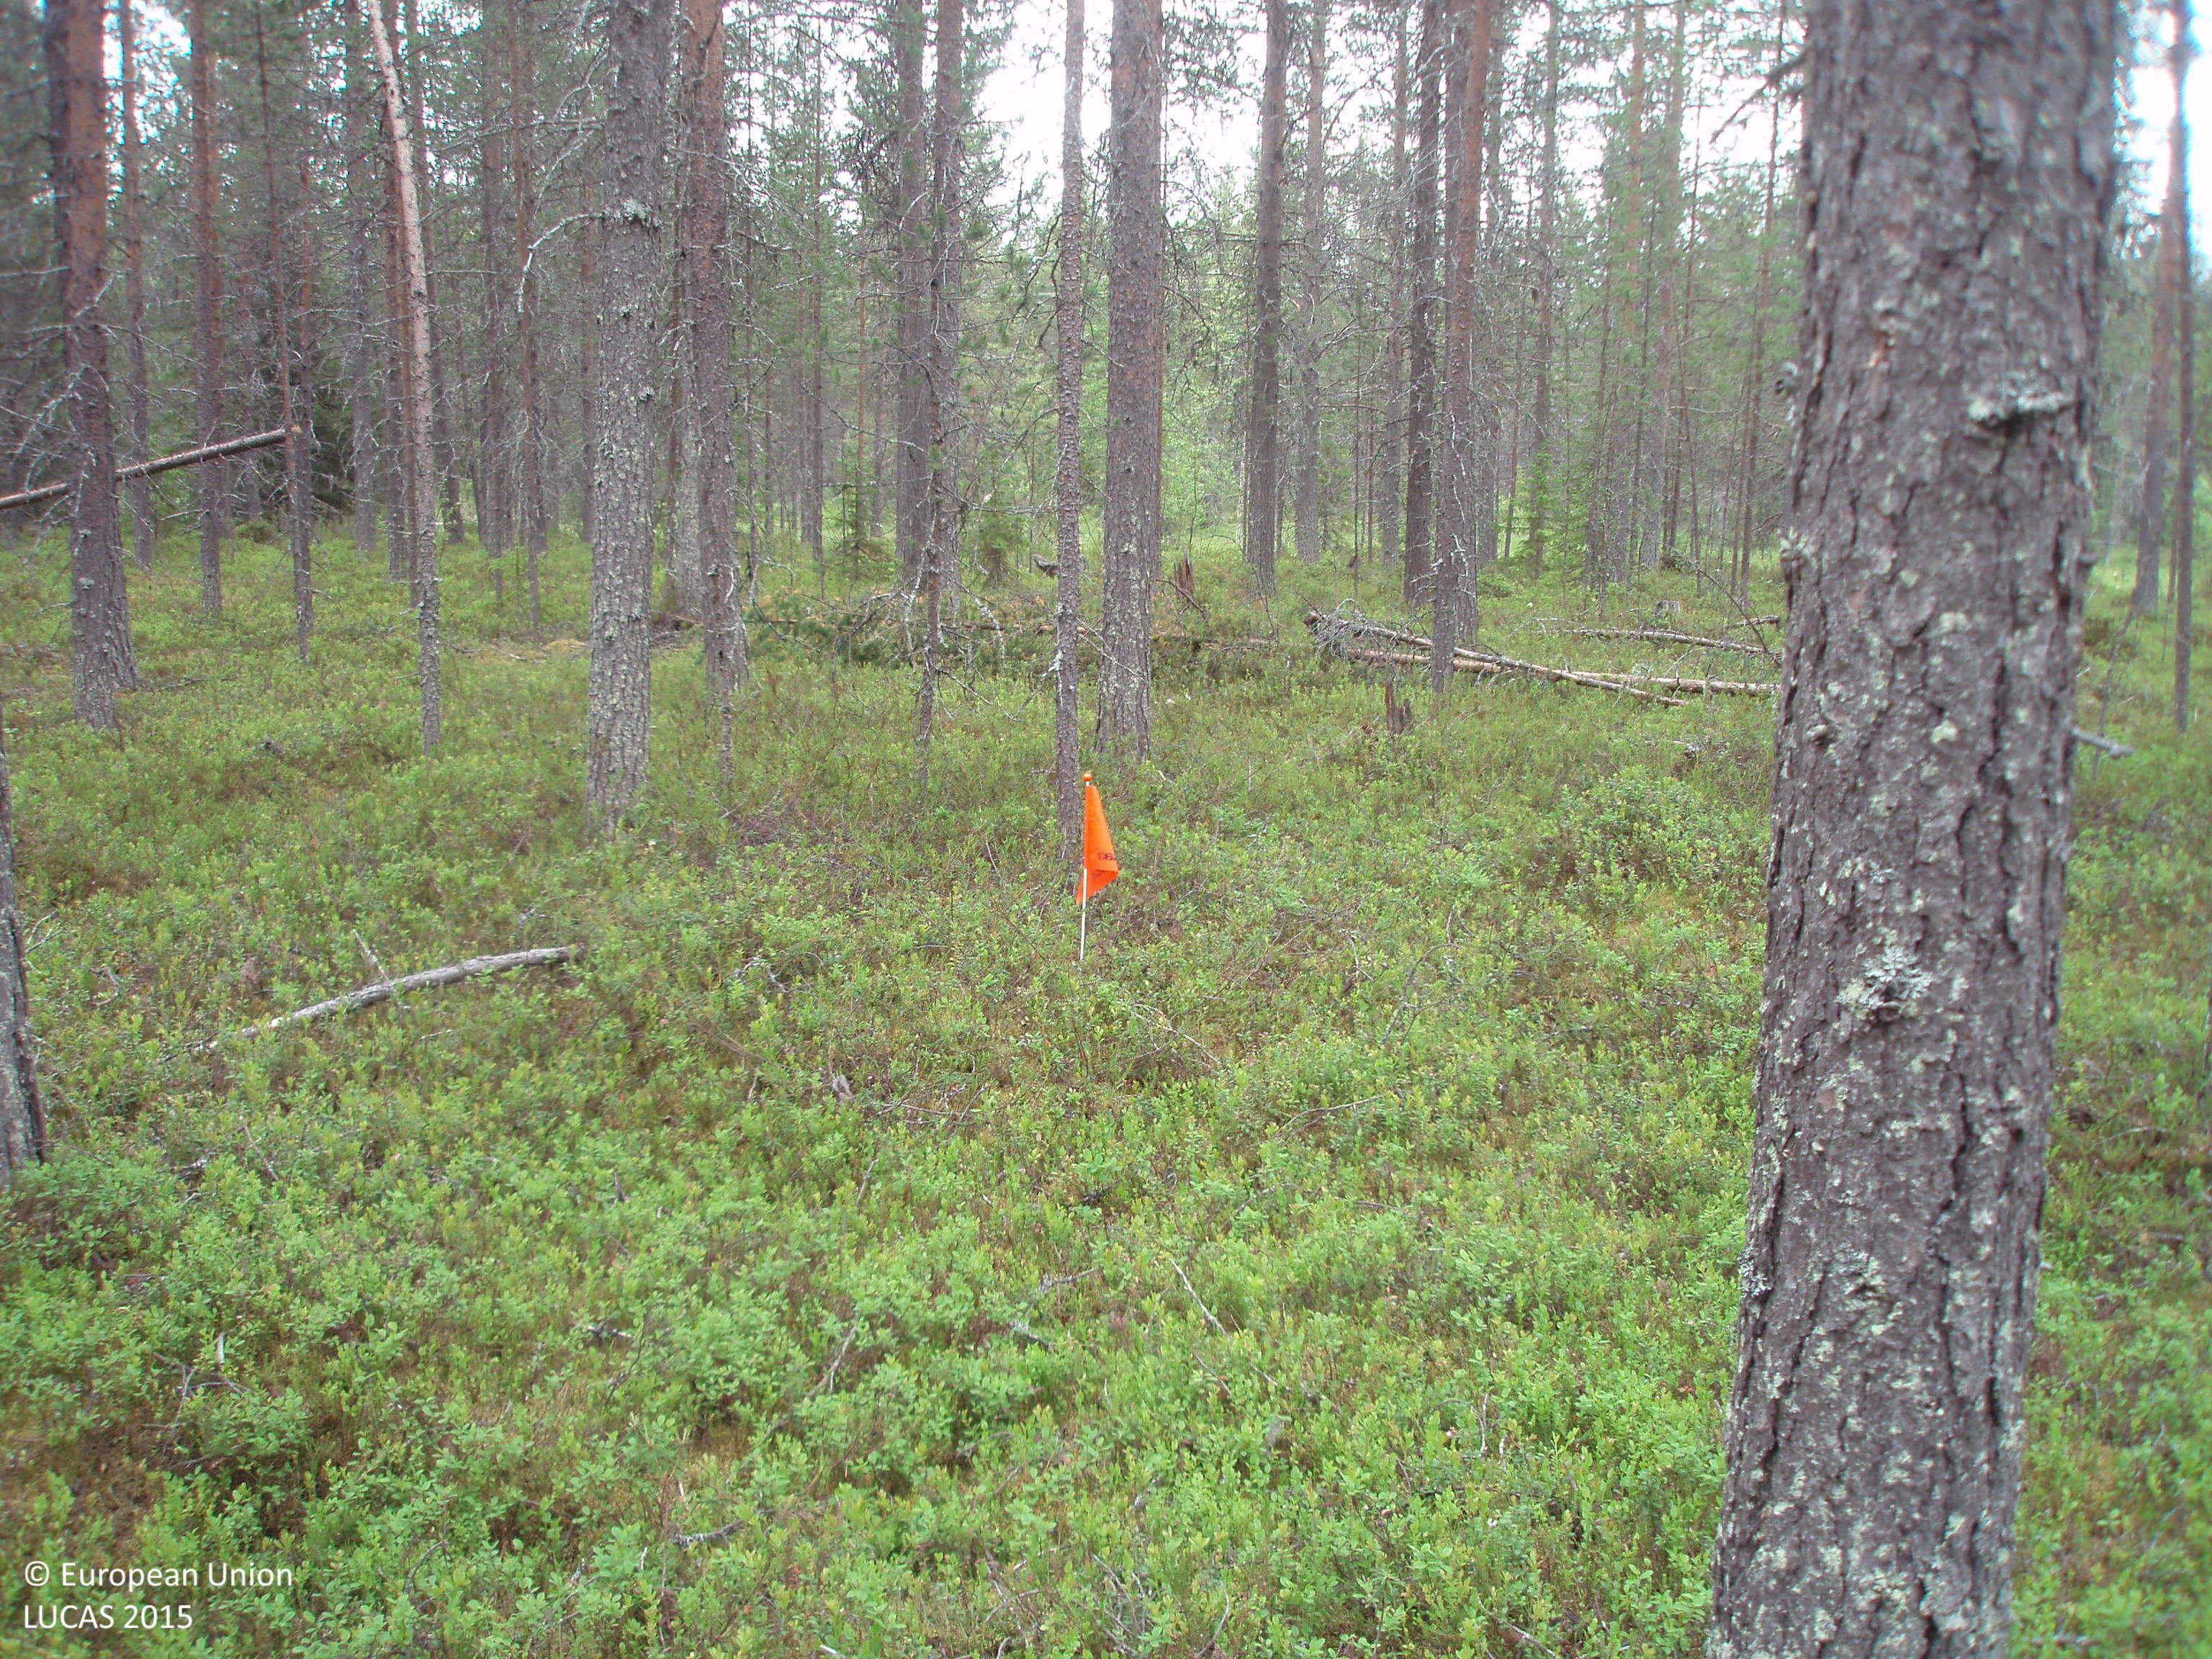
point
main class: Woodland
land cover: Pine dominated coniferous woodland
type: boreal forest
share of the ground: > 75 %
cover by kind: coniferous forest trees 75 %, shrubs 25 %
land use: Forestry
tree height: > 5 m
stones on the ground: < 10 %
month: July
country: FI
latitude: 67.3108
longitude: 28.2202
